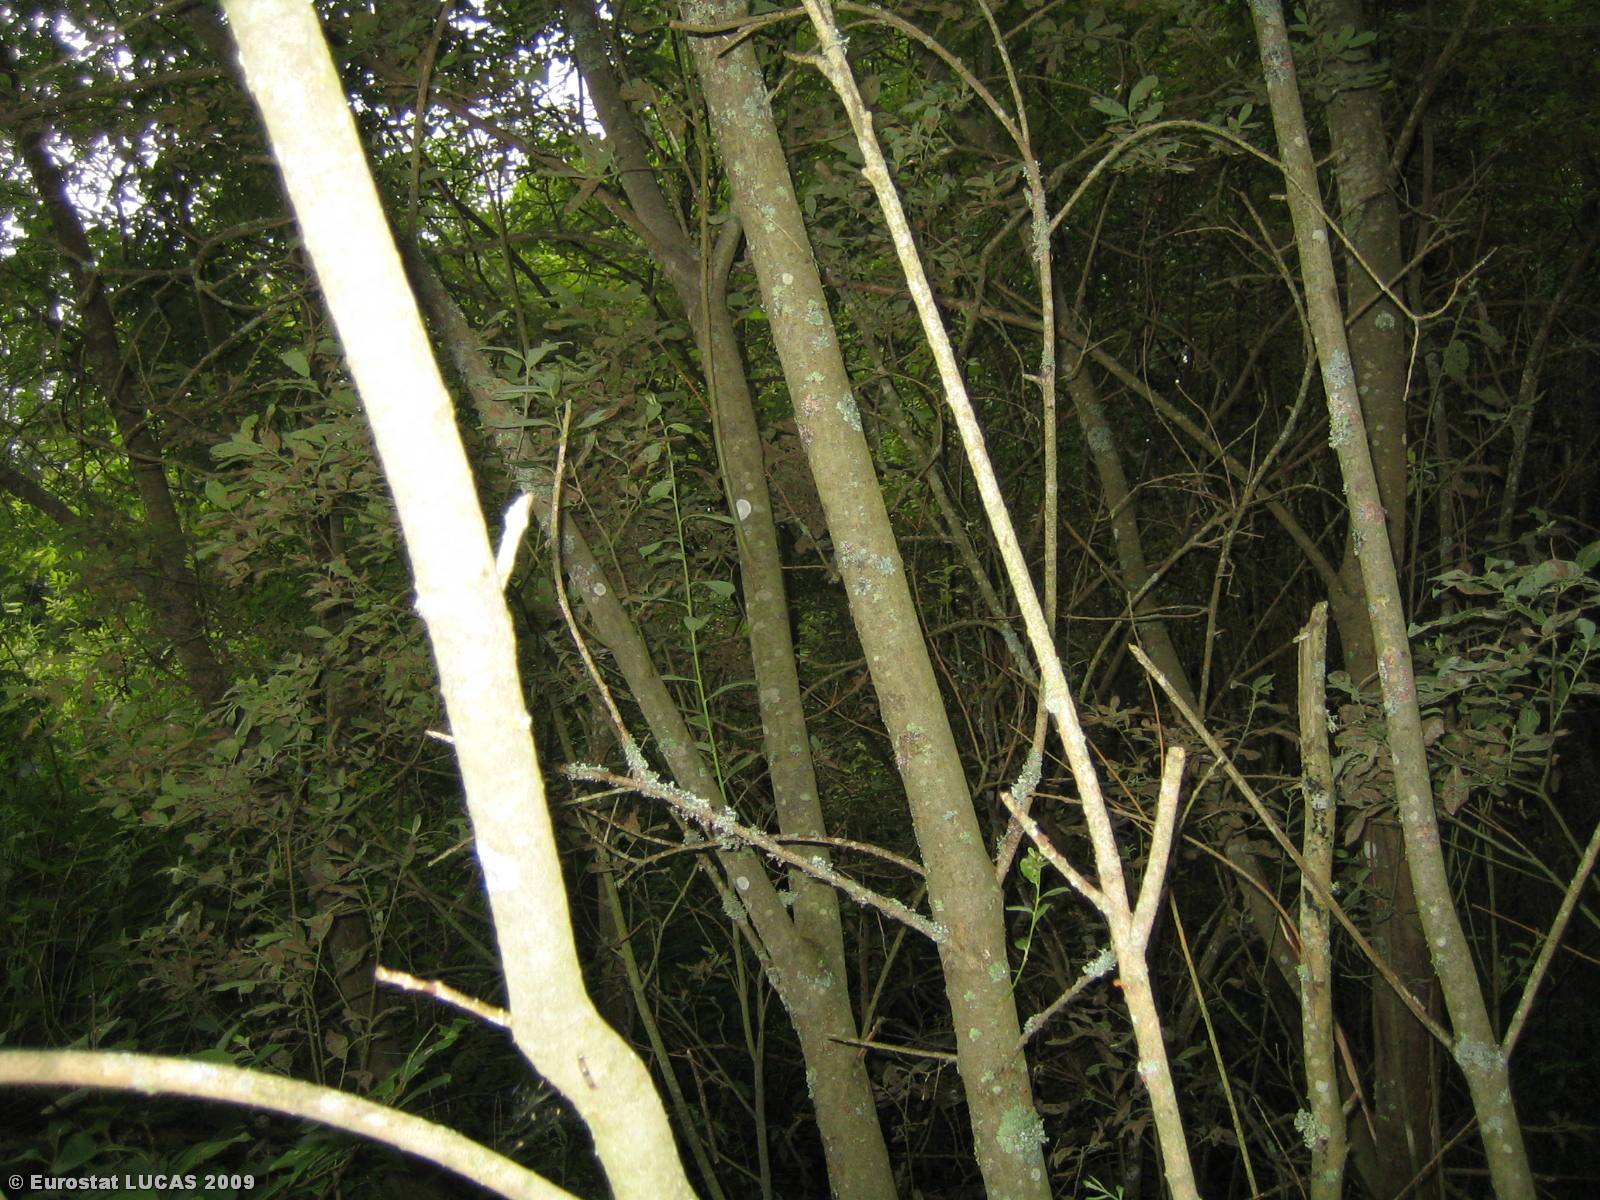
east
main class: Woodland
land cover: Broadleaved woodland
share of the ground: > 75 %
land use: Forestry
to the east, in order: Broadleaved woodland; Grassland without tree/shrub cover; Broadleaved woodland; Groves; Tracks; Grassland without tree/shrub cover
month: July
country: LT
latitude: 55.4989
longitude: 25.4629
